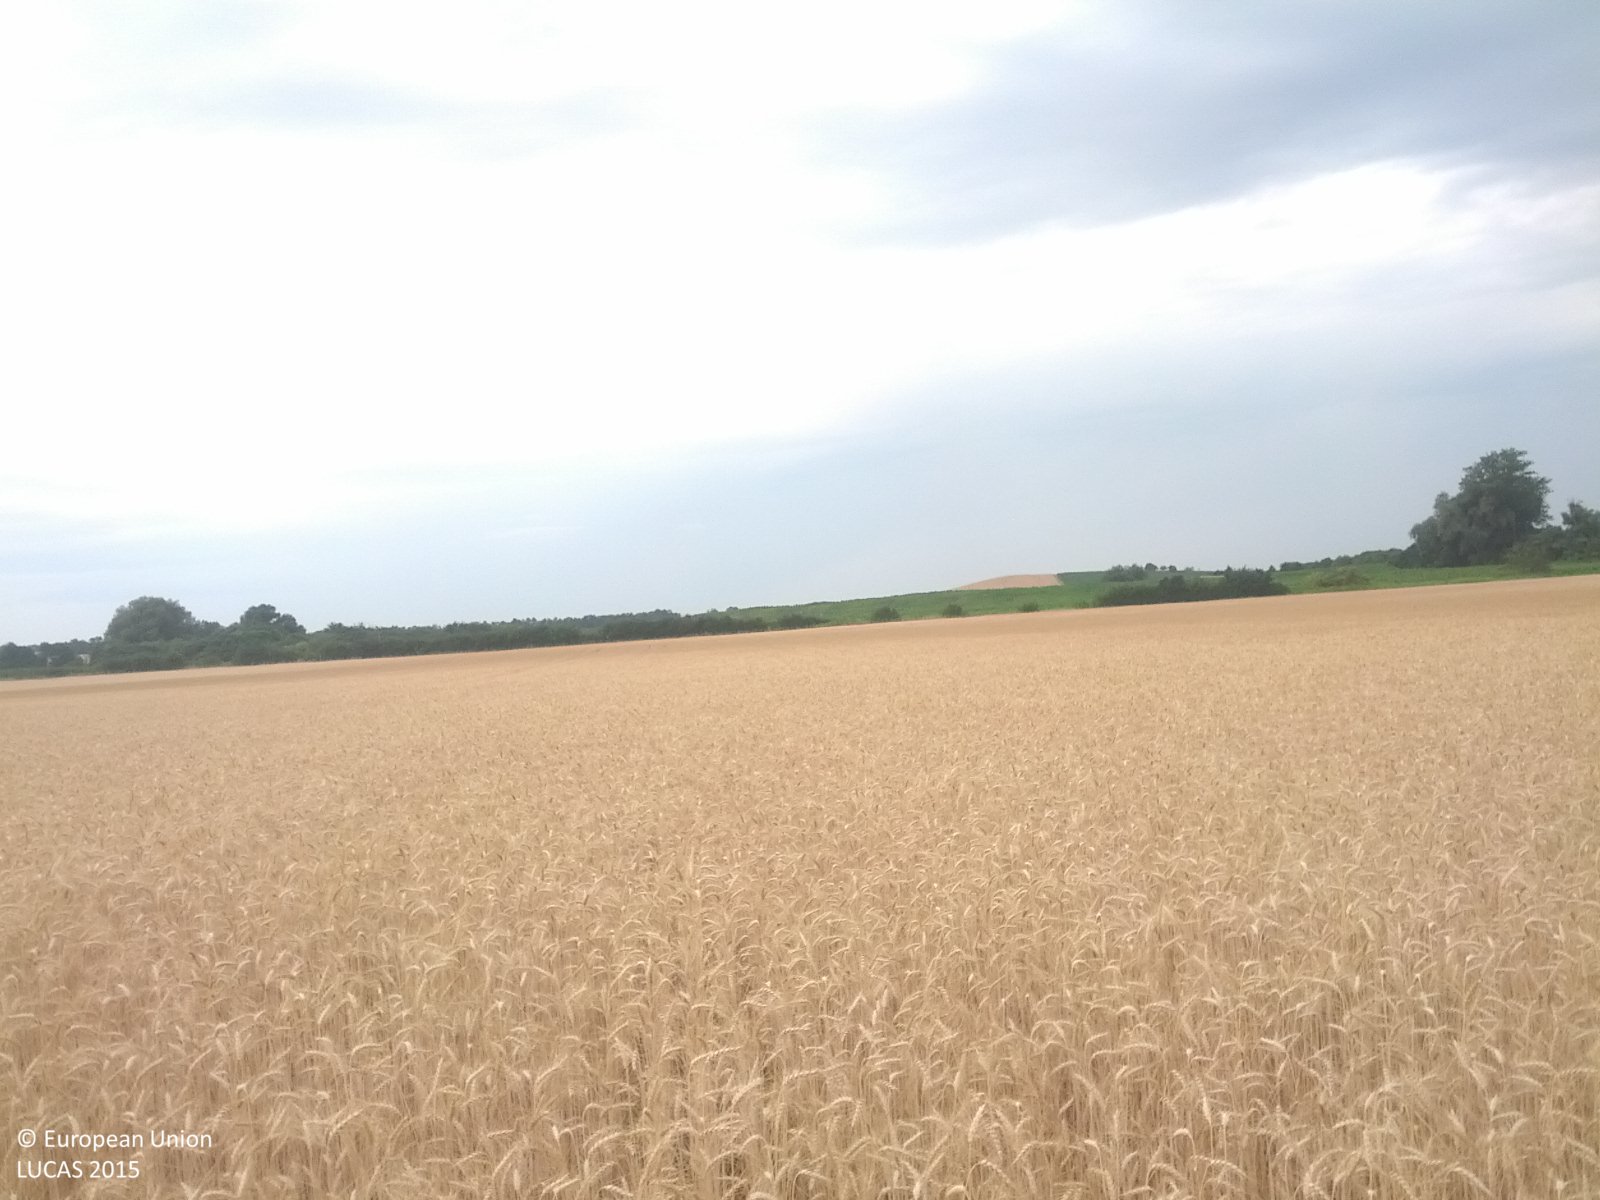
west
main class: Cropland
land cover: Common wheat
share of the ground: > 75 %
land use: Agriculture (excluding fallow land and kitchen gardens)
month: July
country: AT
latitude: 48.7818
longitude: 16.6348
